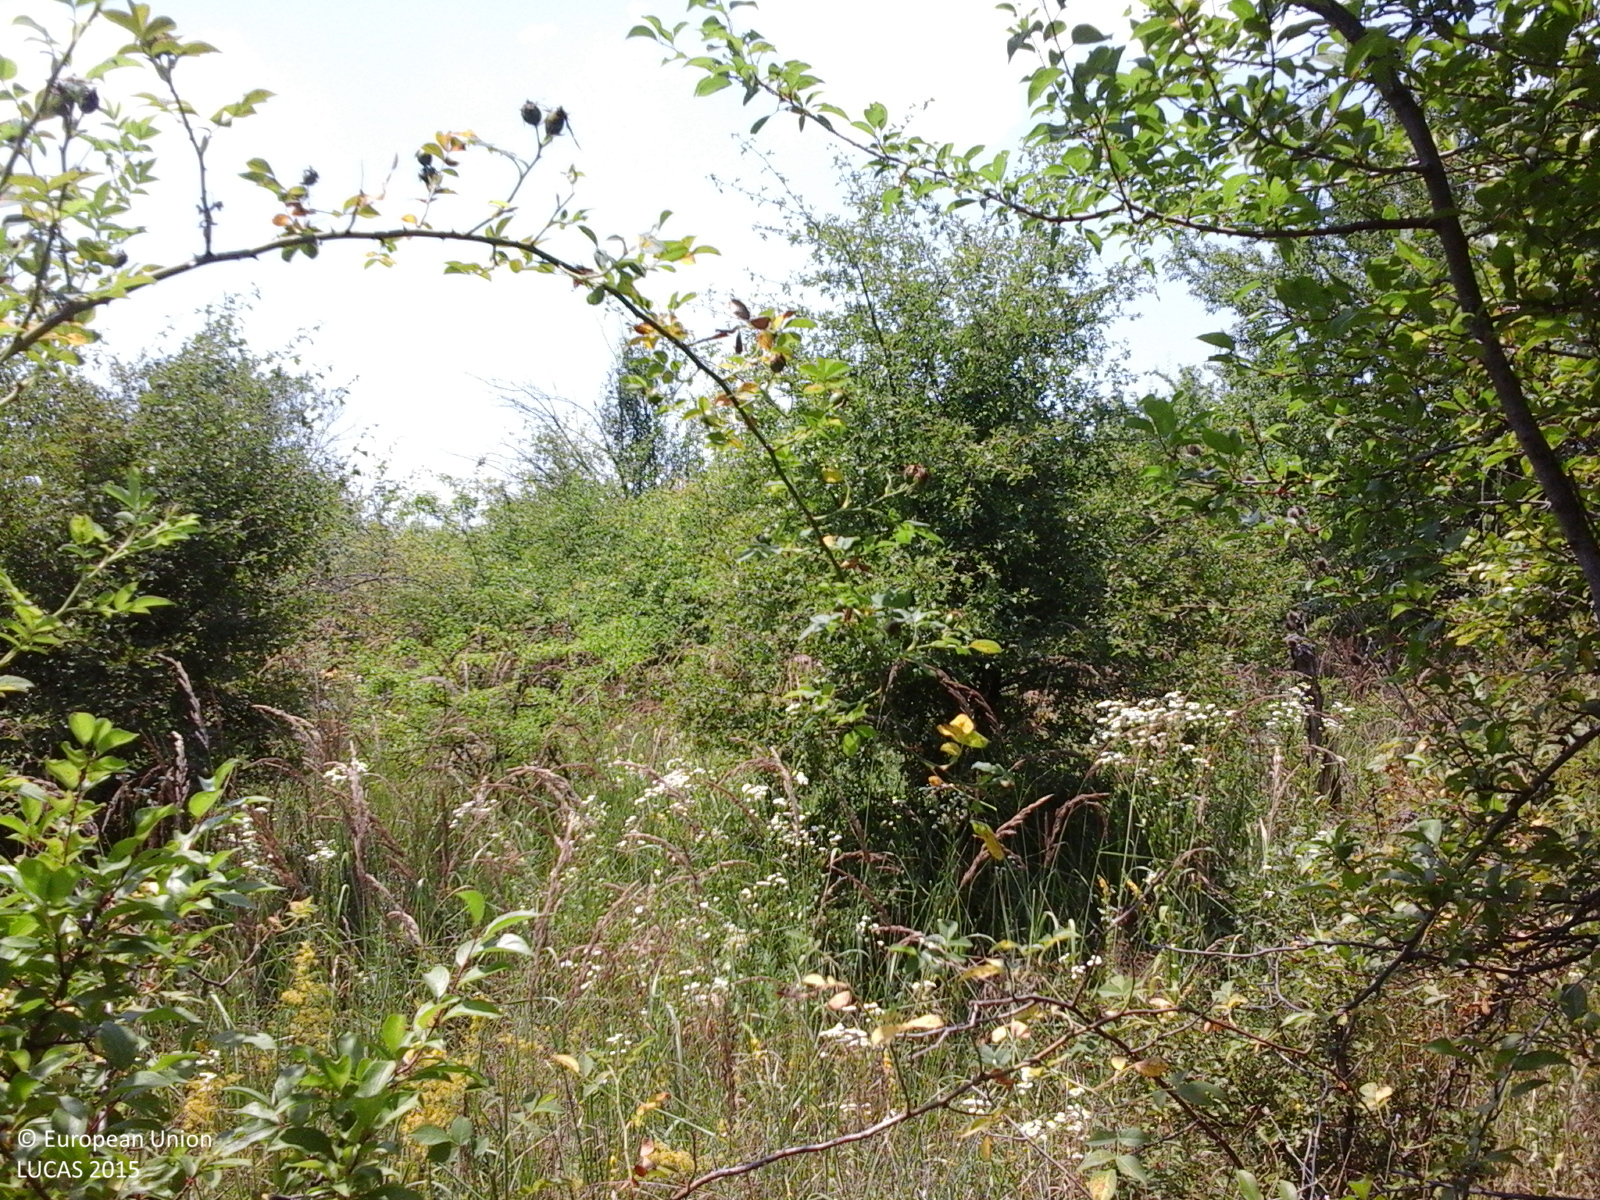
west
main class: Cropland
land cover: Other fruit trees and berries
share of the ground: > 75 %
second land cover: Shrubland without tree cover
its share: 50 - 75 %
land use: Abandoned areas
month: July
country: RO
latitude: 44.7515
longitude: 24.5112
